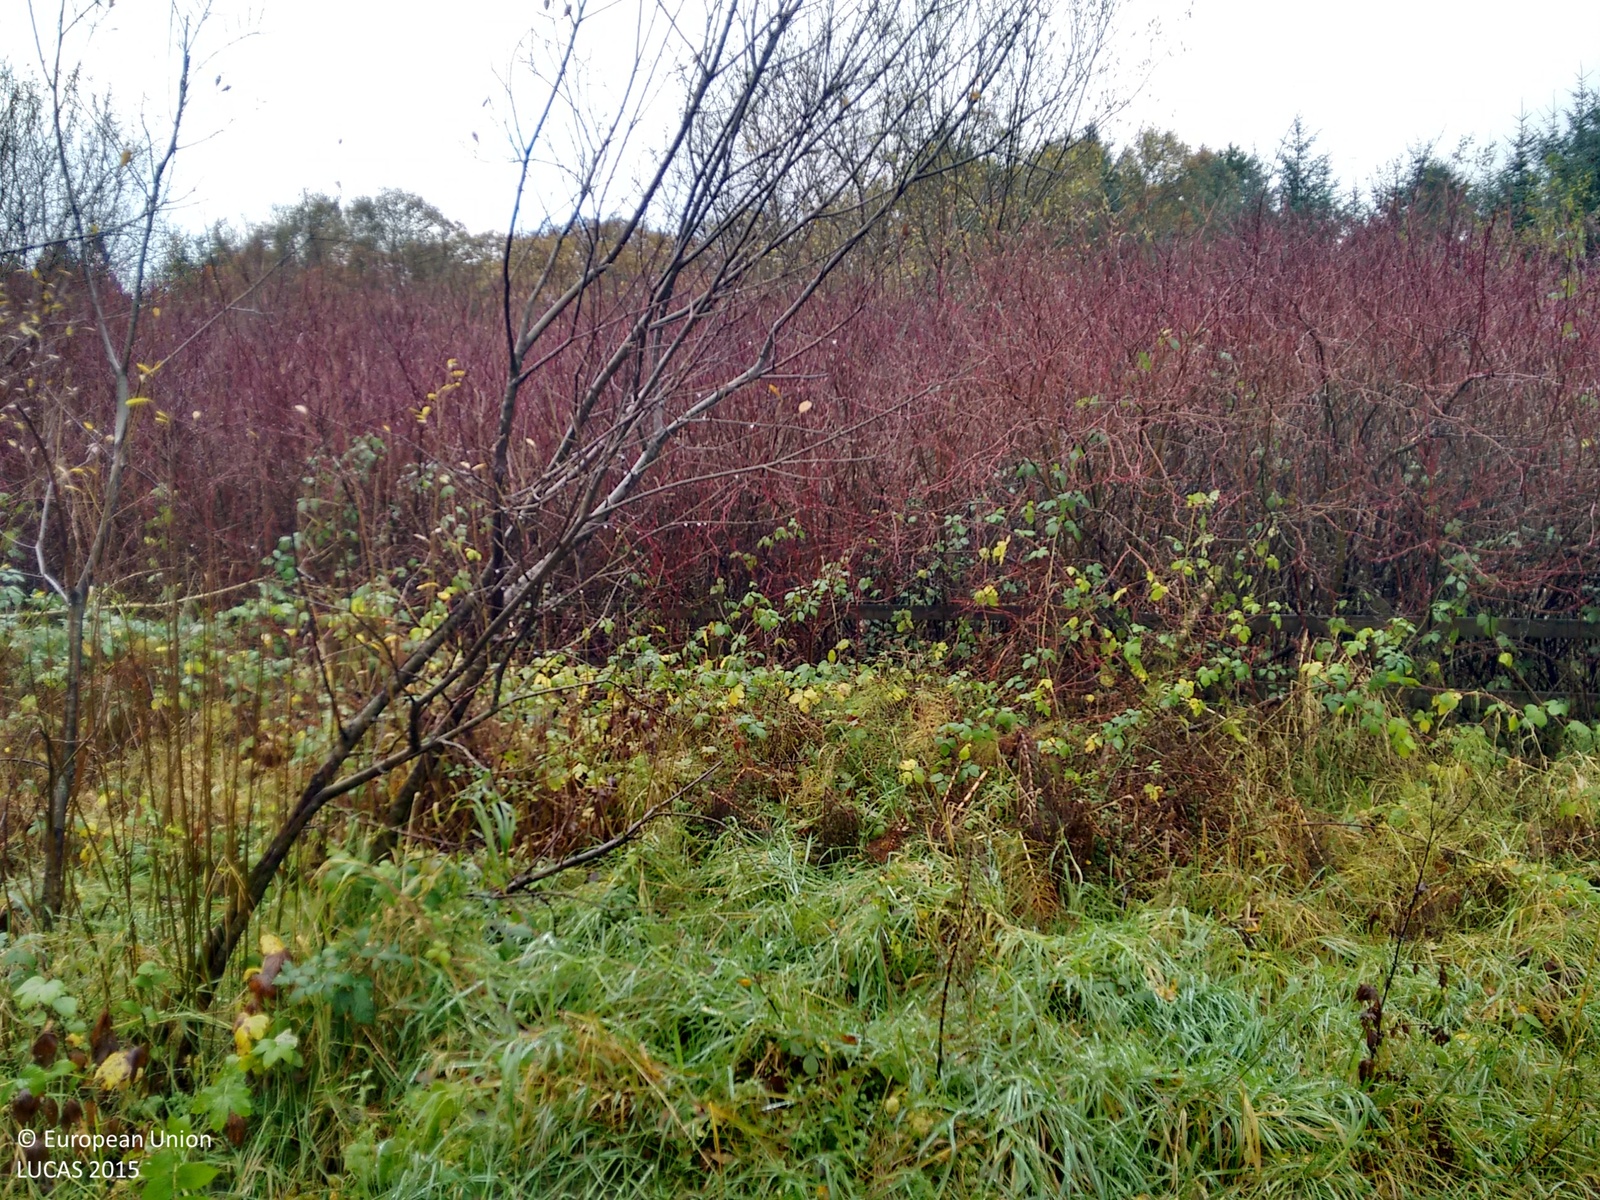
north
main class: Woodland
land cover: Pine dominated mixed woodland
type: exotic forest
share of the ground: > 75 %
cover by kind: coniferous forest trees 70 %, broadleaved forest trees 25 %, herbaceous plants 5 %
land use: Forestry
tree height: > 5 m
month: November
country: IE
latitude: 53.9357
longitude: -8.0116
